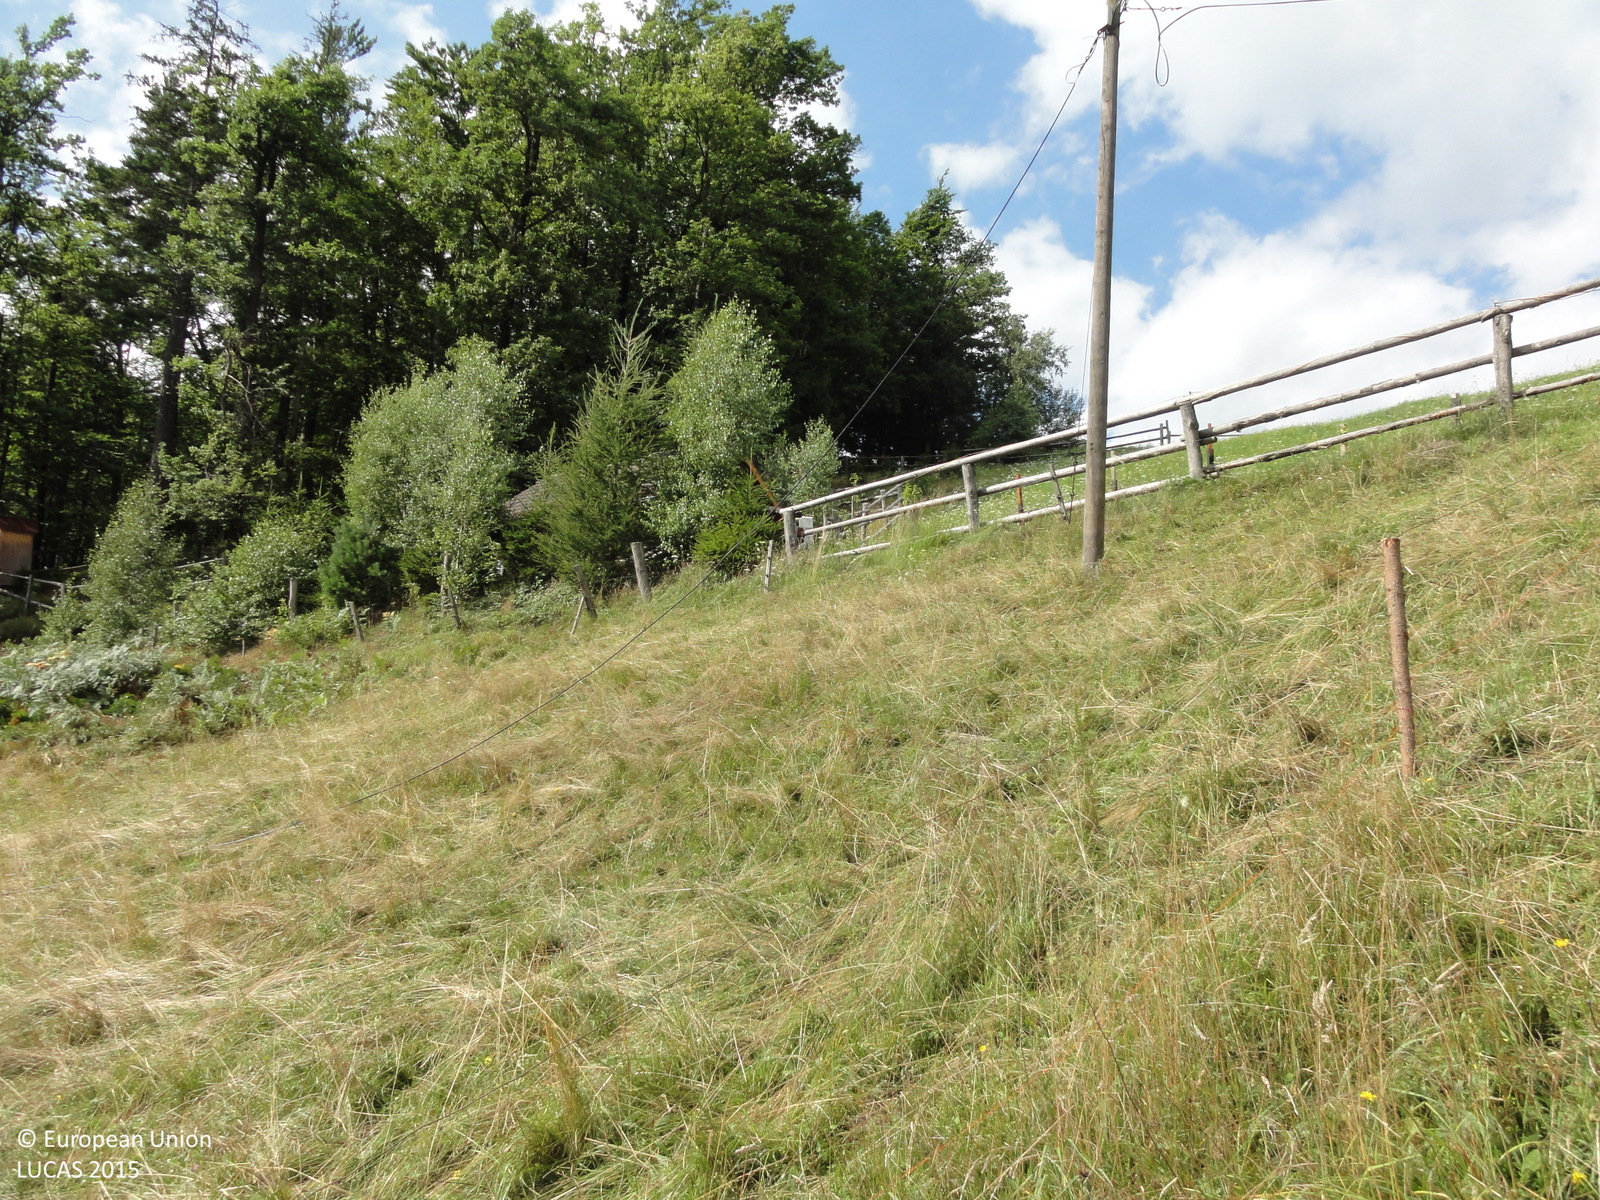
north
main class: Grassland
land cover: Grassland without tree/shrub cover
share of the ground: > 75 %
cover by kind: herbaceous plants 100 %
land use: Agriculture (excluding fallow land and kitchen gardens)
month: July
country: SI
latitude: 46.4275
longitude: 15.1120
